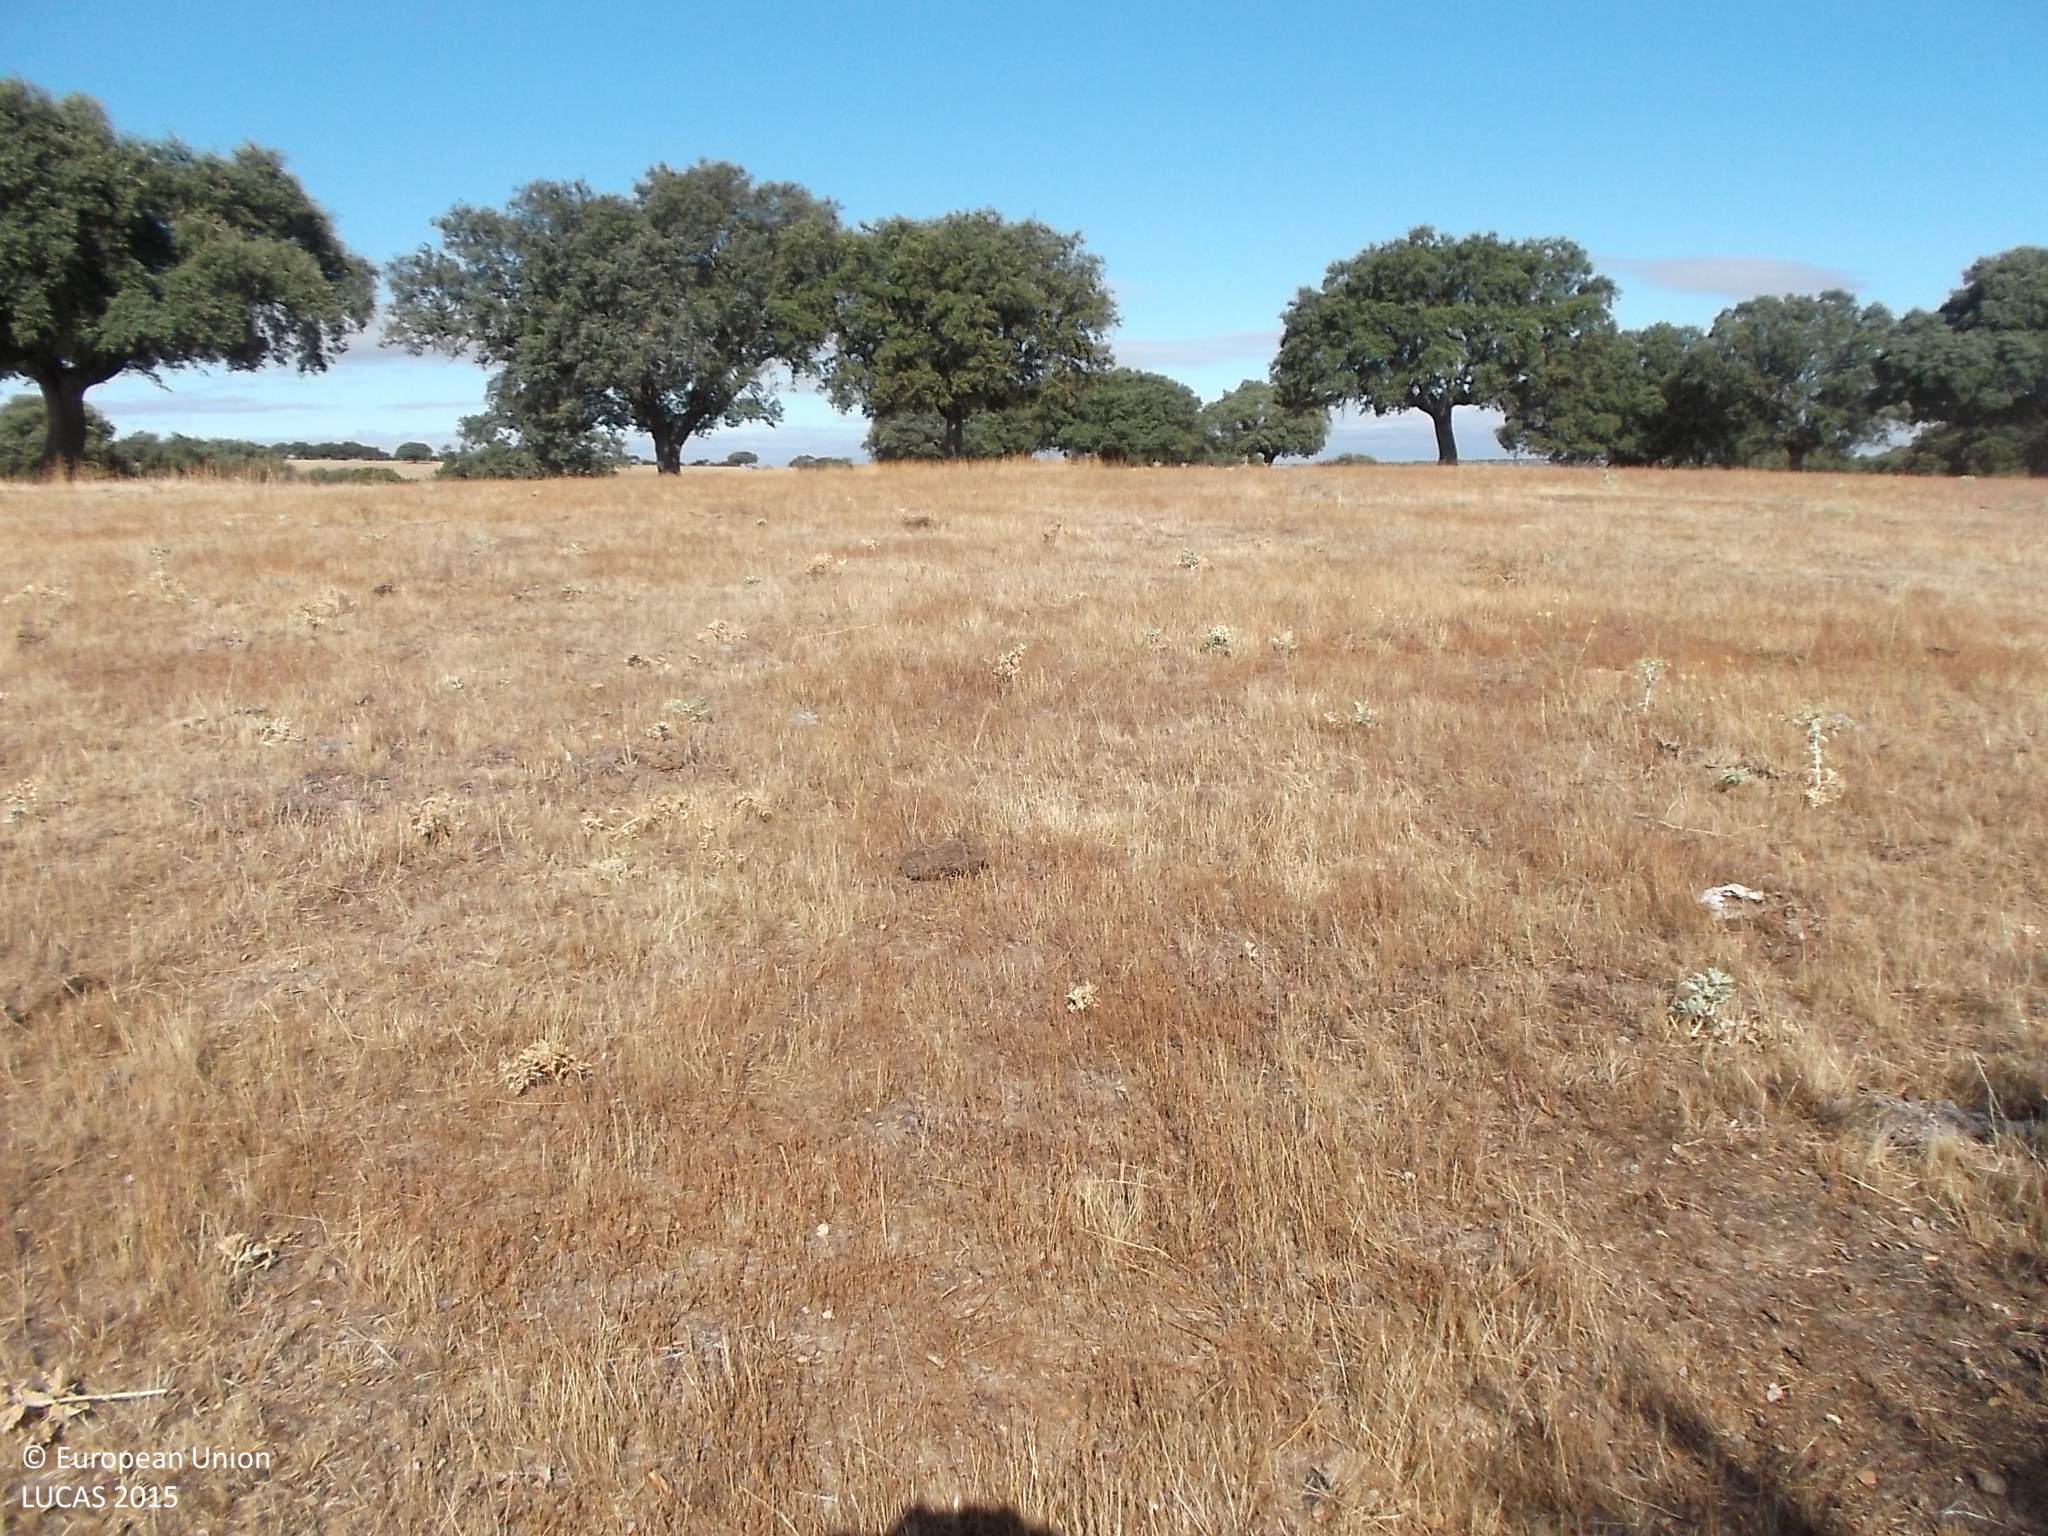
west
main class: Woodland
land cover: Broadleaved woodland
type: broadleaved evergreen forest
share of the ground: 10 - 25 %
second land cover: Grassland without tree/shrub cover
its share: > 75 %
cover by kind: herbaceous plants 85 %, broadleaved forest trees 15 %
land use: Forestry
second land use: Agriculture (excluding fallow land and kitchen gardens)
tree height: < 5 m
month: July
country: ES
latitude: 40.8837
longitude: -6.2882
